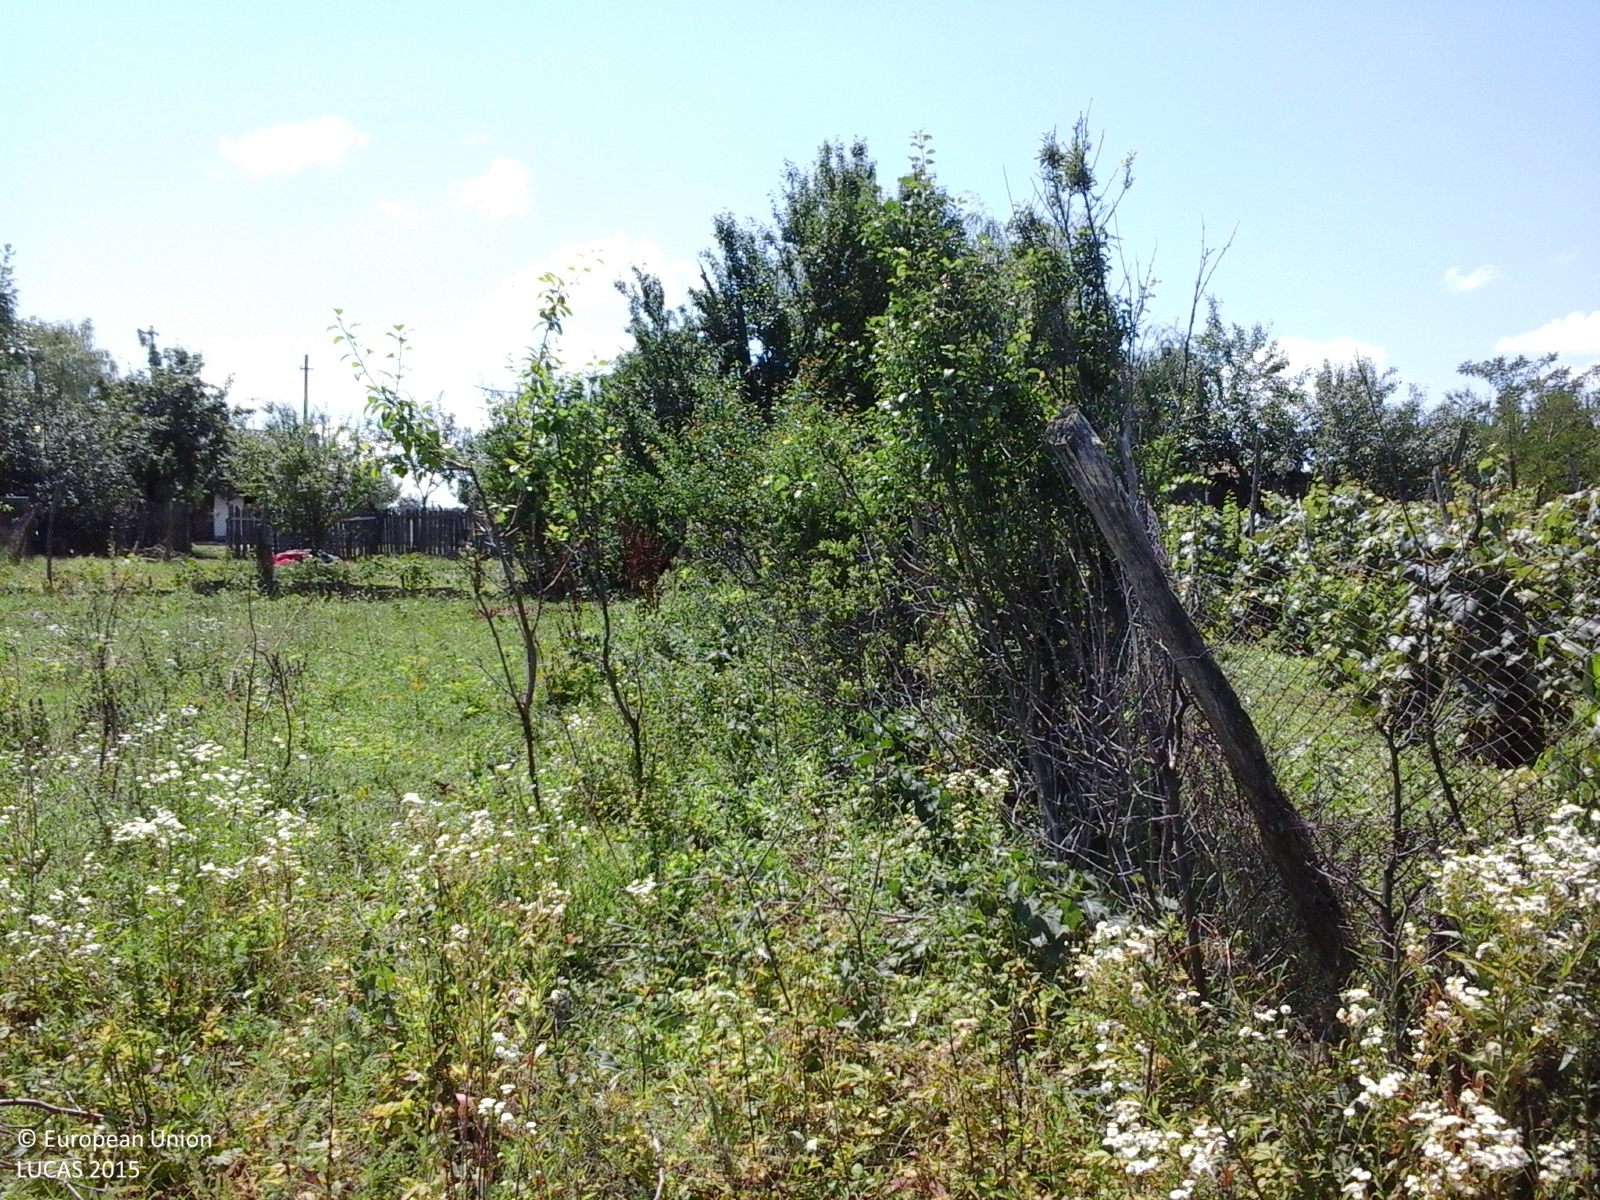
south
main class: Cropland
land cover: Vineyards
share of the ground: 50 - 75 %
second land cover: Grassland without tree/shrub cover
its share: 25 - 50 %
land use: Agriculture (excluding fallow land and kitchen gardens)
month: July
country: RO
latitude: 44.2366
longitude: 24.7861
